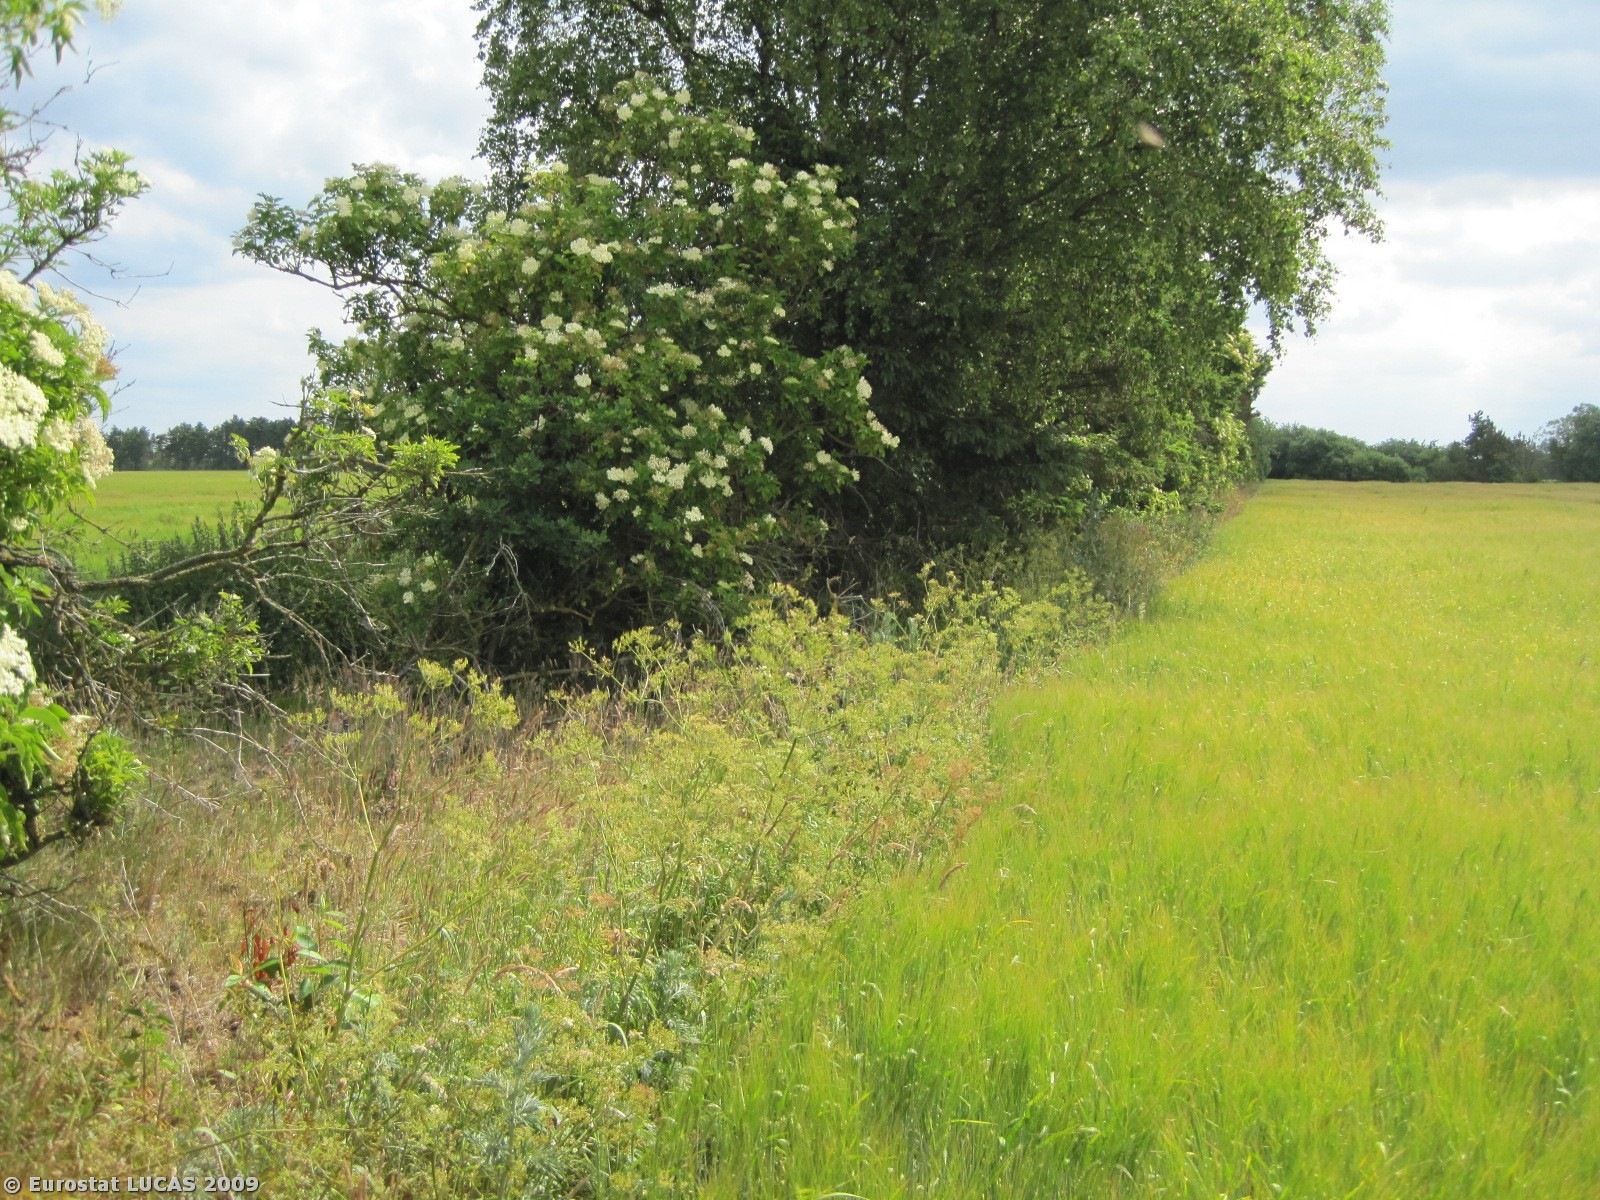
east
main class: Cropland
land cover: Barley
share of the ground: > 75 %
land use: Agriculture (excluding fallow land and kitchen gardens)
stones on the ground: < 10 %
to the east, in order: Barley; Grassland without tree/shrub cover; Mixed woodland; Ditches and canals; Grass margins; Barley; Grass margins; Ditches and canals; Mixed woodland; Grass margins; Barley
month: June
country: DK
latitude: 56.3255
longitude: 8.7563
